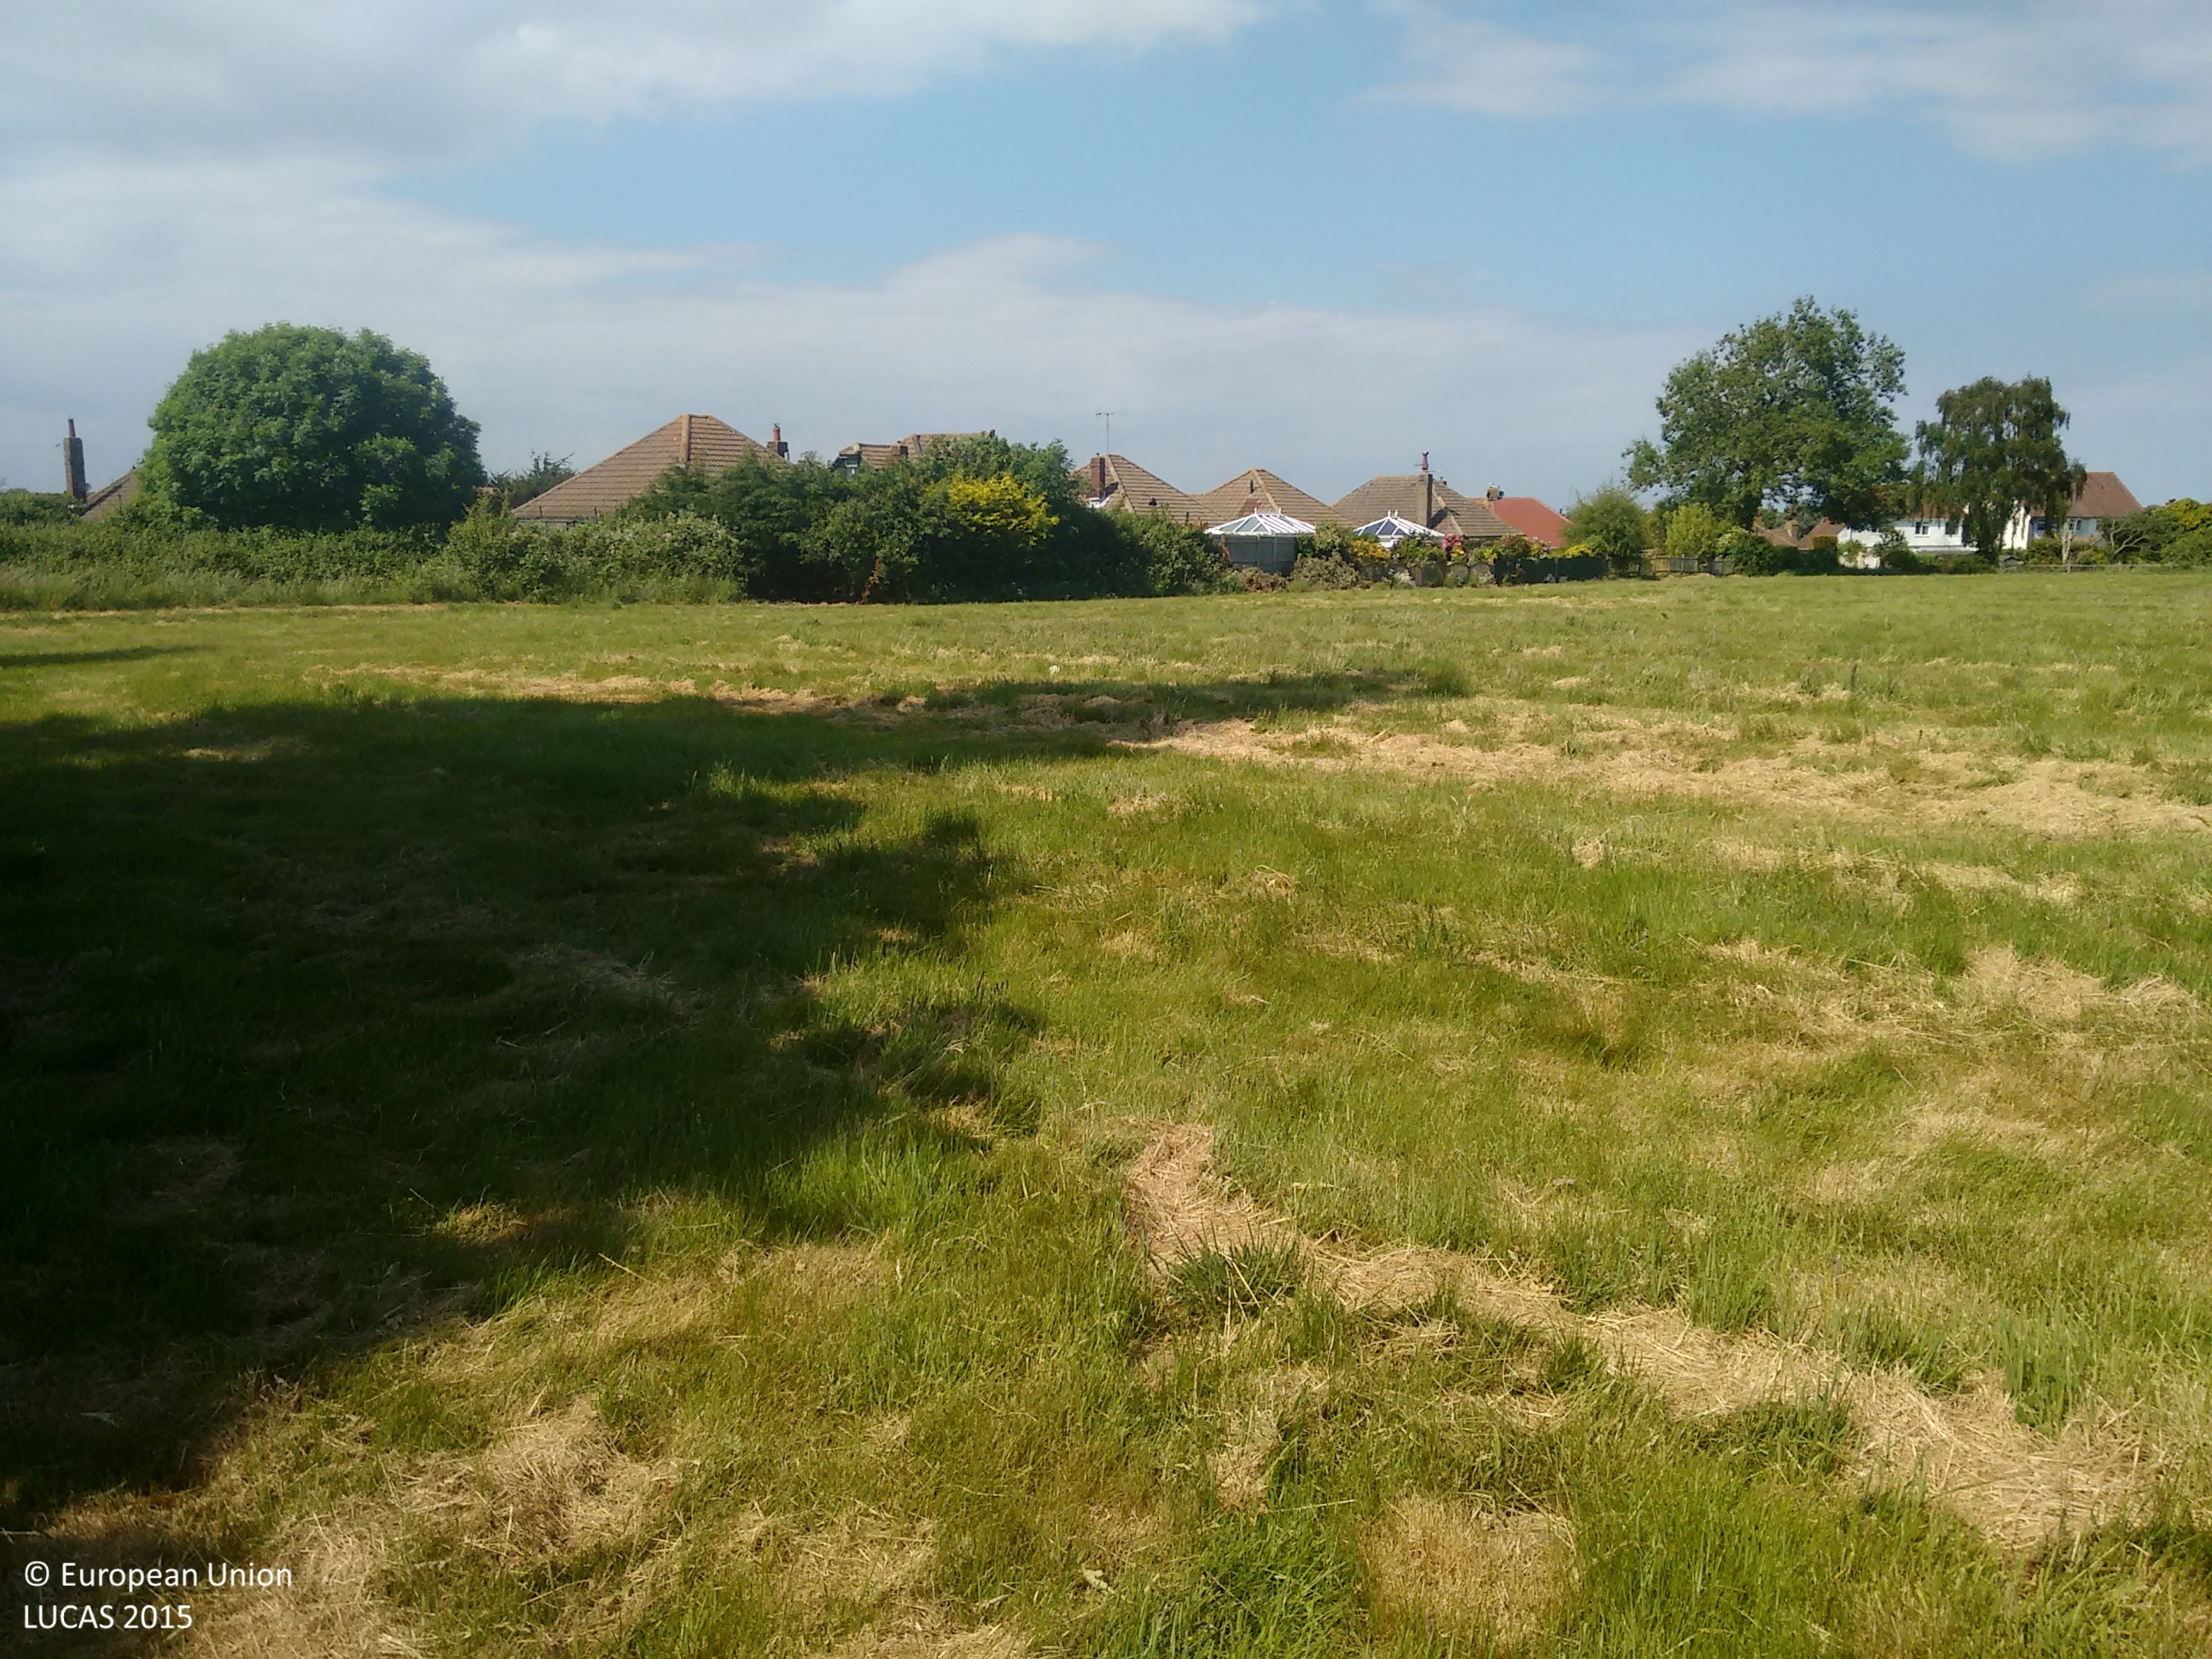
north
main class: Grassland
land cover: Grassland without tree/shrub cover
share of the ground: > 75 %
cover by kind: herbaceous plants 100 %
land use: Amenities, museums, leisure
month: June
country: GB
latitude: 50.8158
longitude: 0.2473
